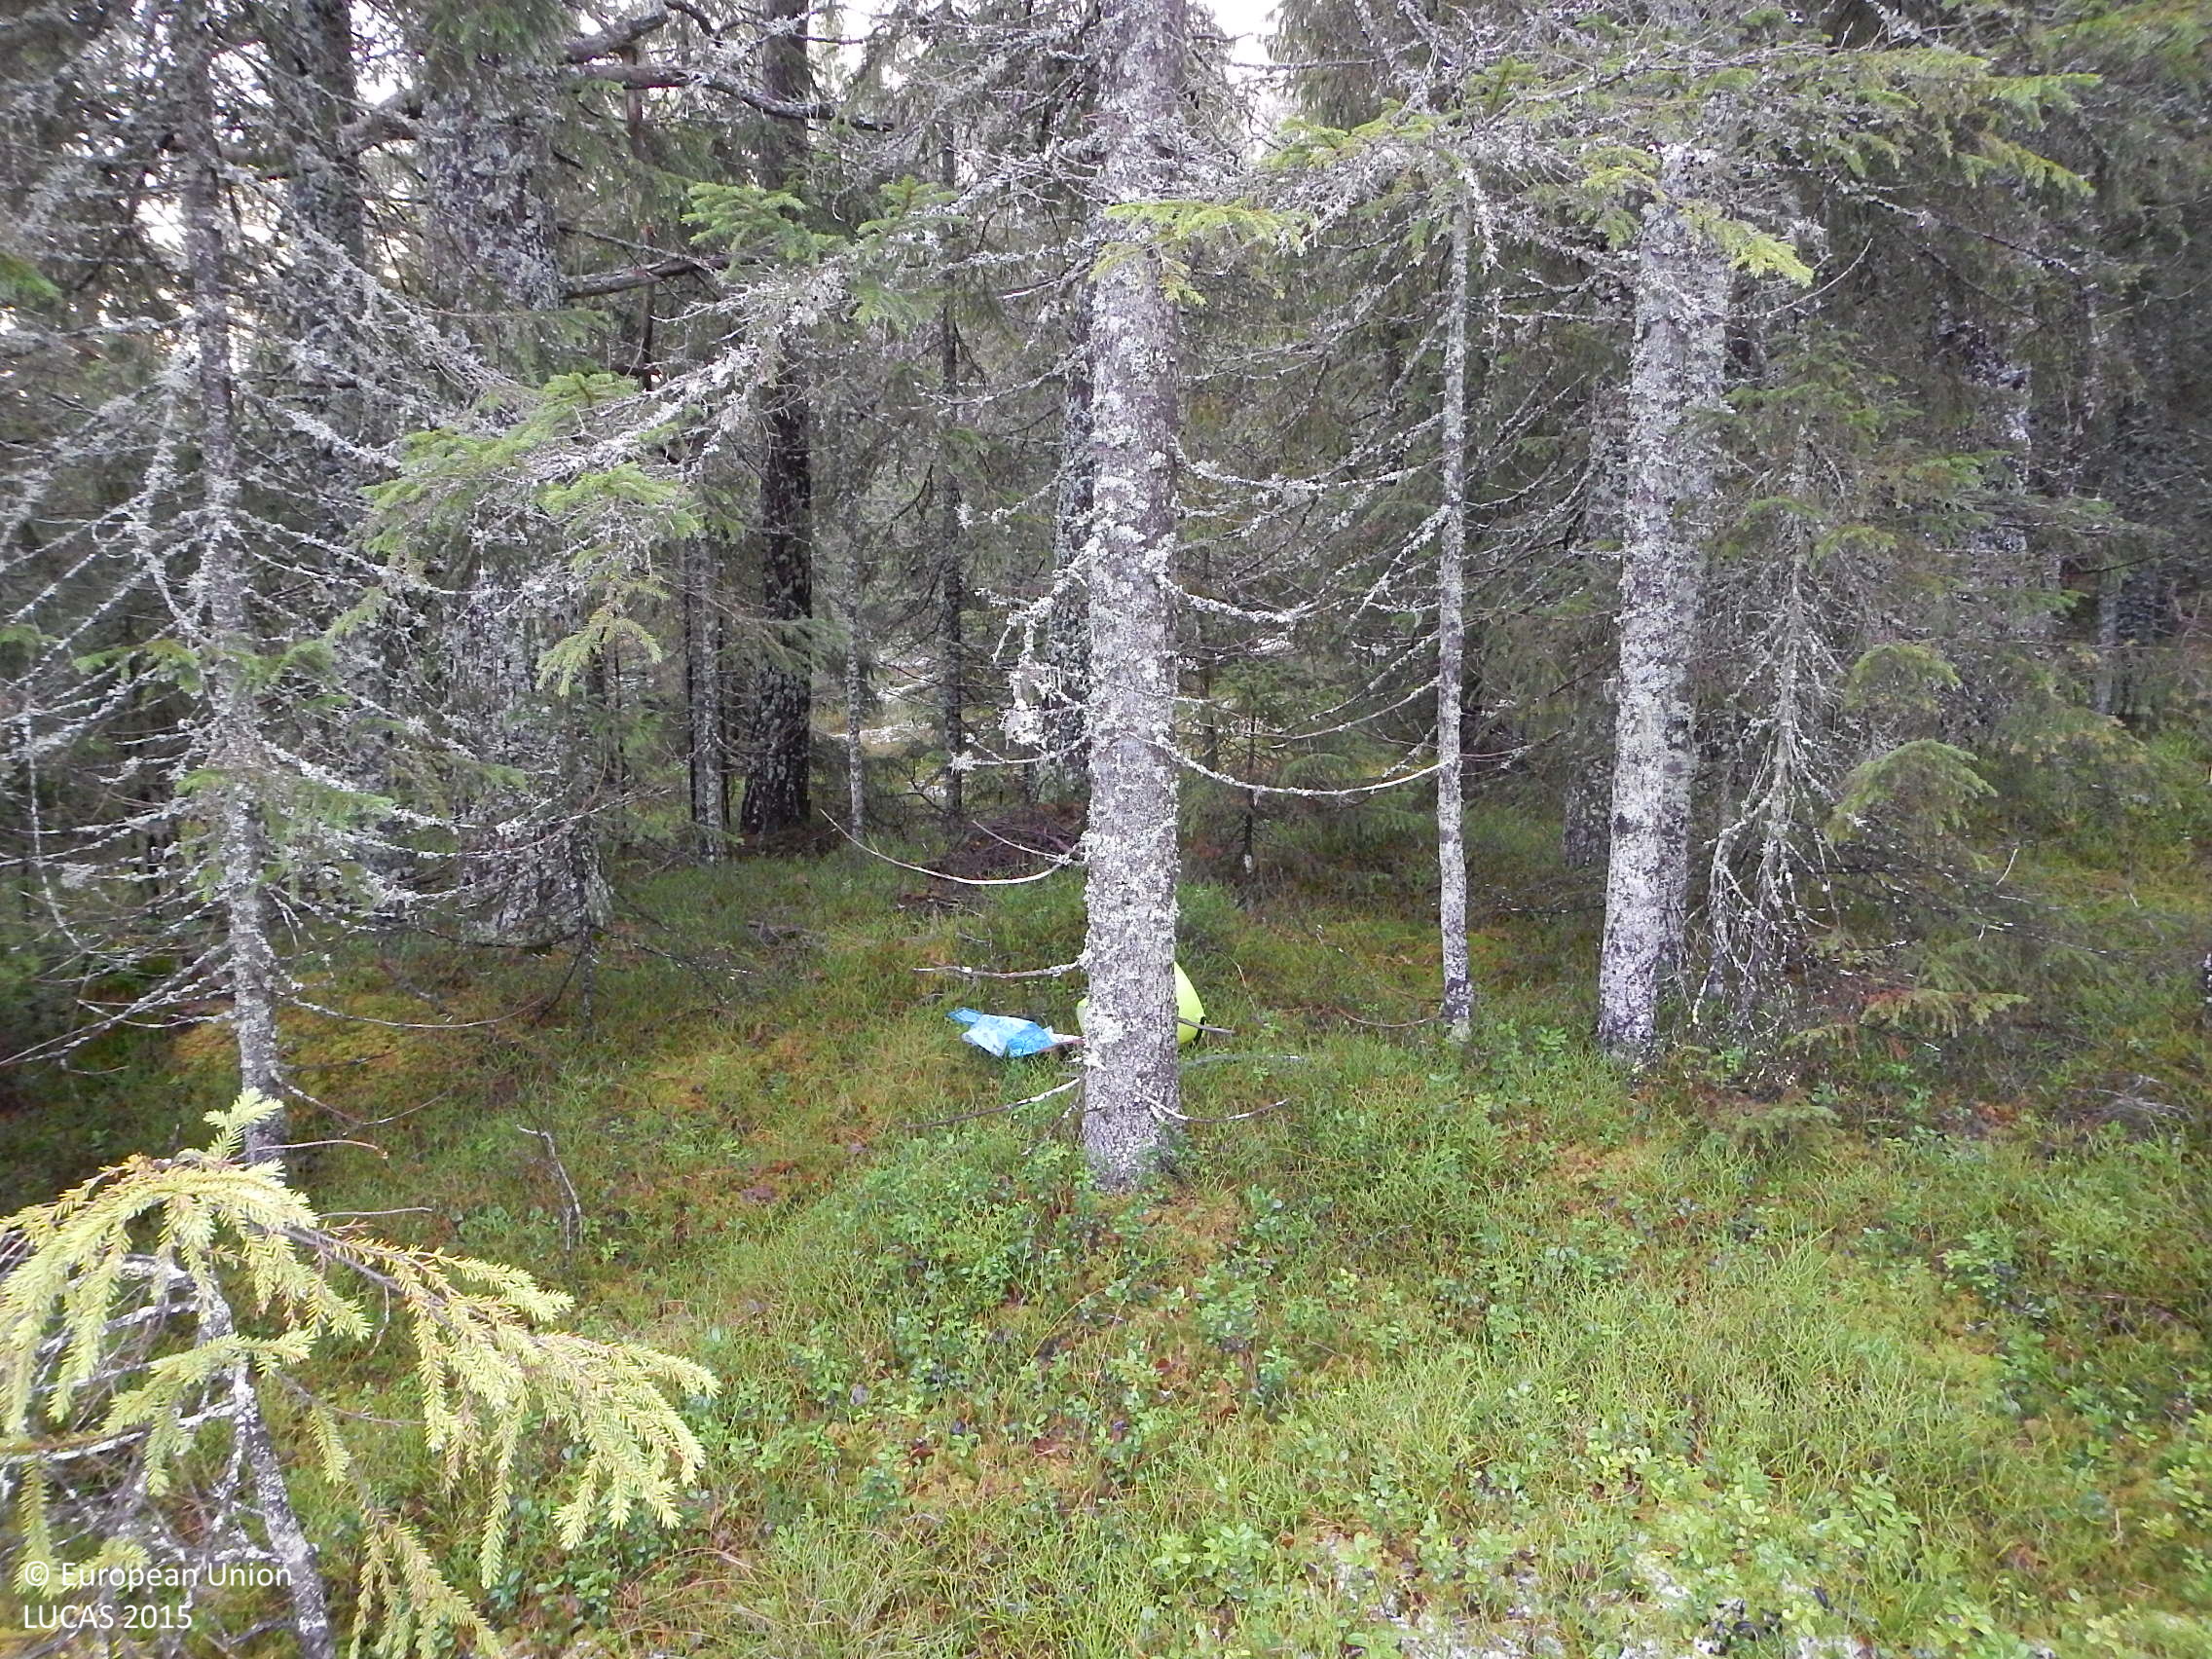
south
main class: Woodland
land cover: Other coniferous woodland
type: boreal forest
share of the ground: 50 - 75 %
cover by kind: coniferous forest trees 70 %, shrubs 20 %, lichens and mosses 10 %
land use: Amenities, museums, leisure
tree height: > 5 m
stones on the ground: < 10 %
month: November
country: SE
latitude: 61.6692
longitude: 16.6514
